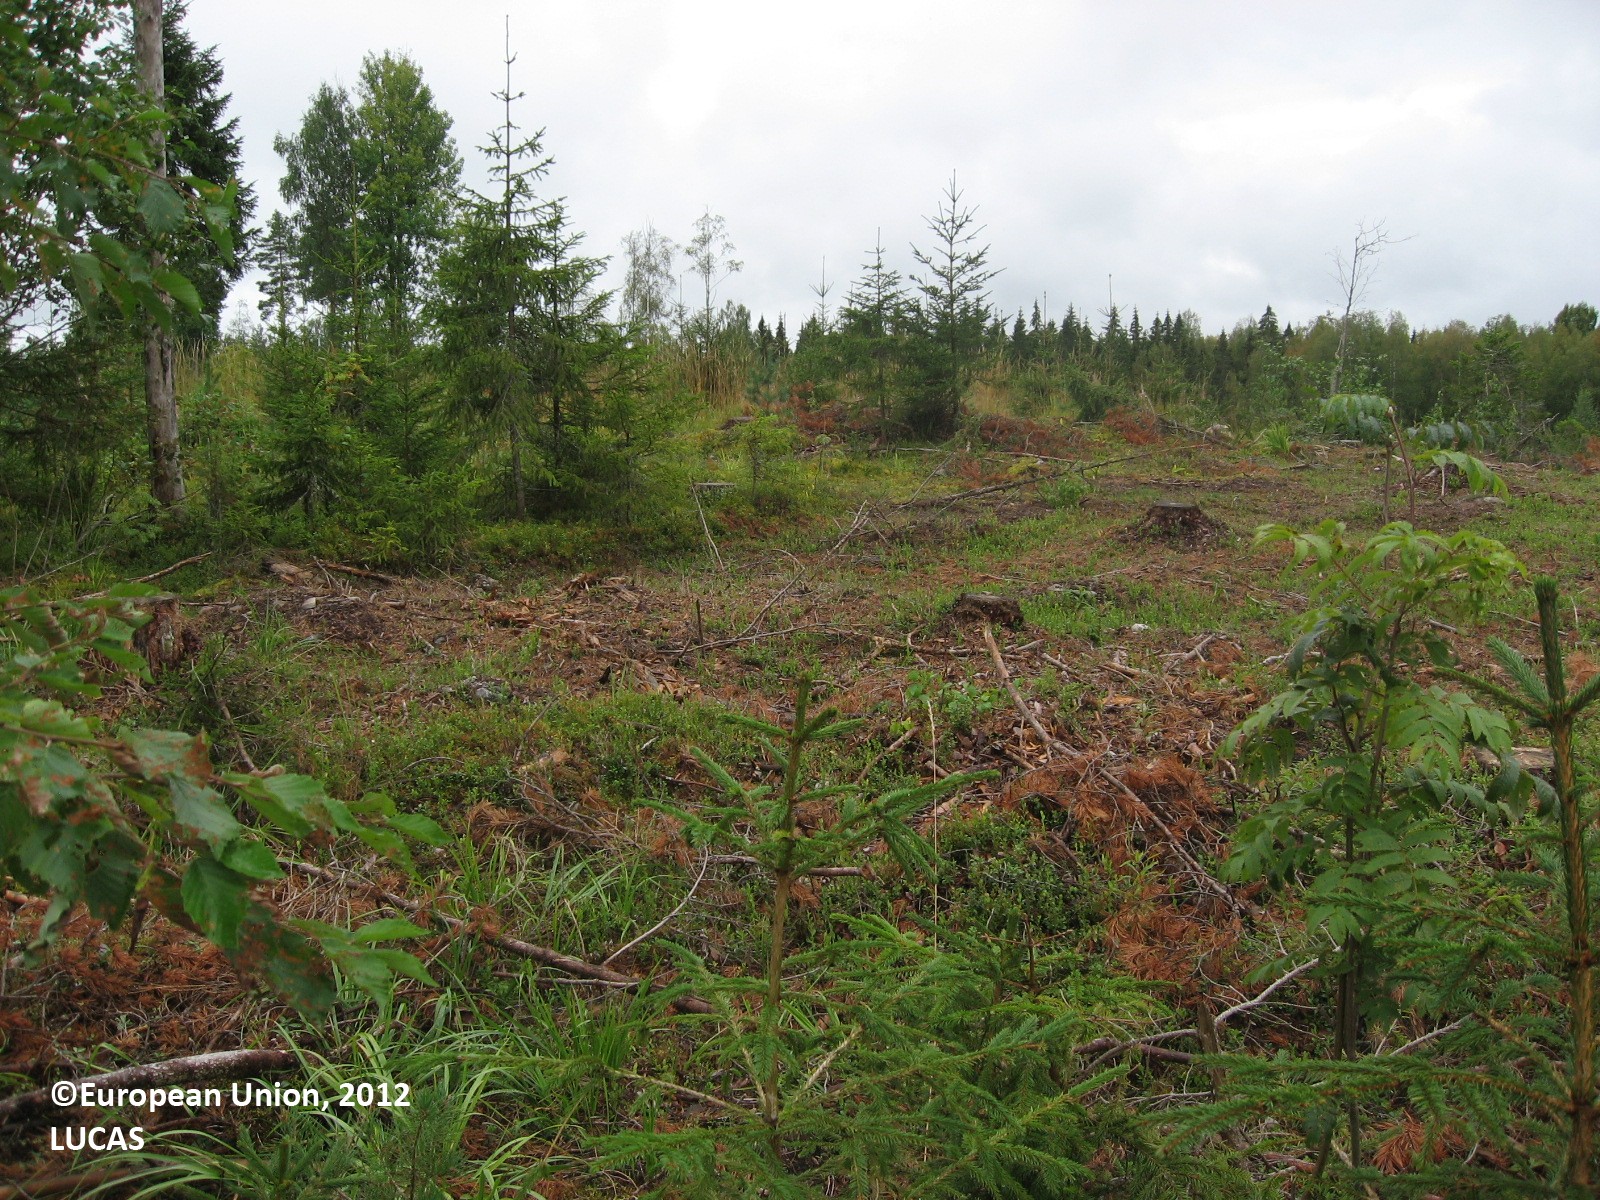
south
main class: Grassland
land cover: Grassland with sparse tree/shrub cover
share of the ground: 50 - 75 %
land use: Forestry
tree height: < 5 m
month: August
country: FI
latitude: 61.4564
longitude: 24.7563
